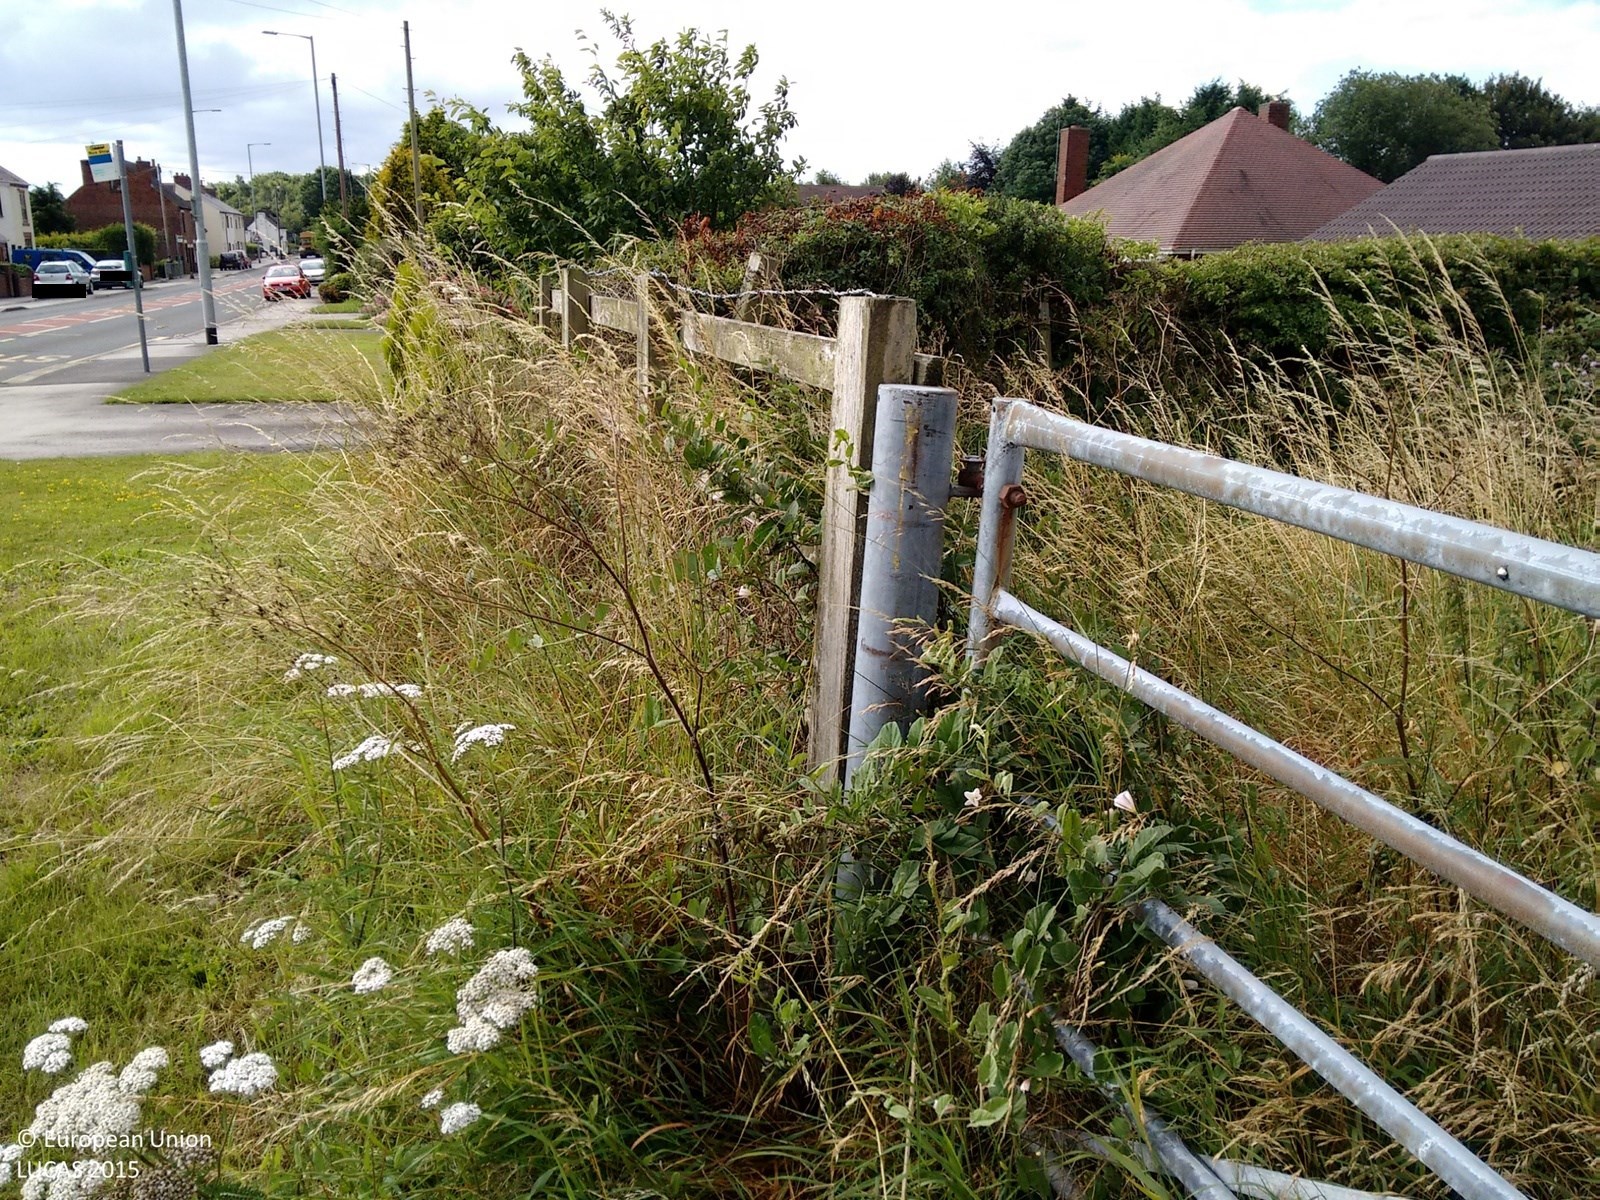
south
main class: Cropland
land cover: Common wheat
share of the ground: > 75 %
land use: Agriculture (excluding fallow land and kitchen gardens)
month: July
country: GB
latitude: 52.6376
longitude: -2.0130
